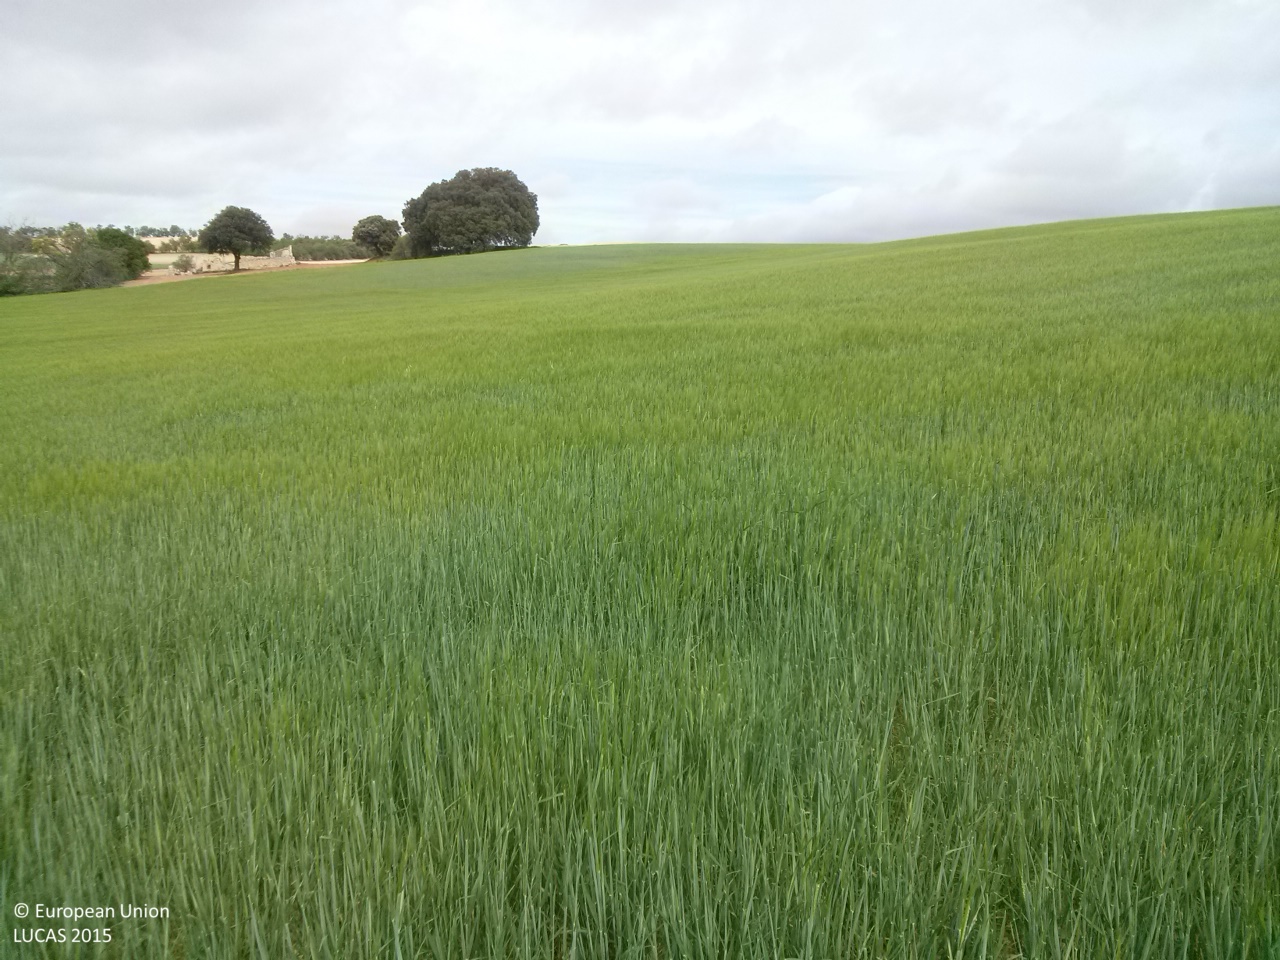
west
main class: Cropland
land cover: Barley
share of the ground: > 75 %
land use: Agriculture (excluding fallow land and kitchen gardens)
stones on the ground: < 10 %
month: May
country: ES
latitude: 39.8555
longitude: -2.8661
